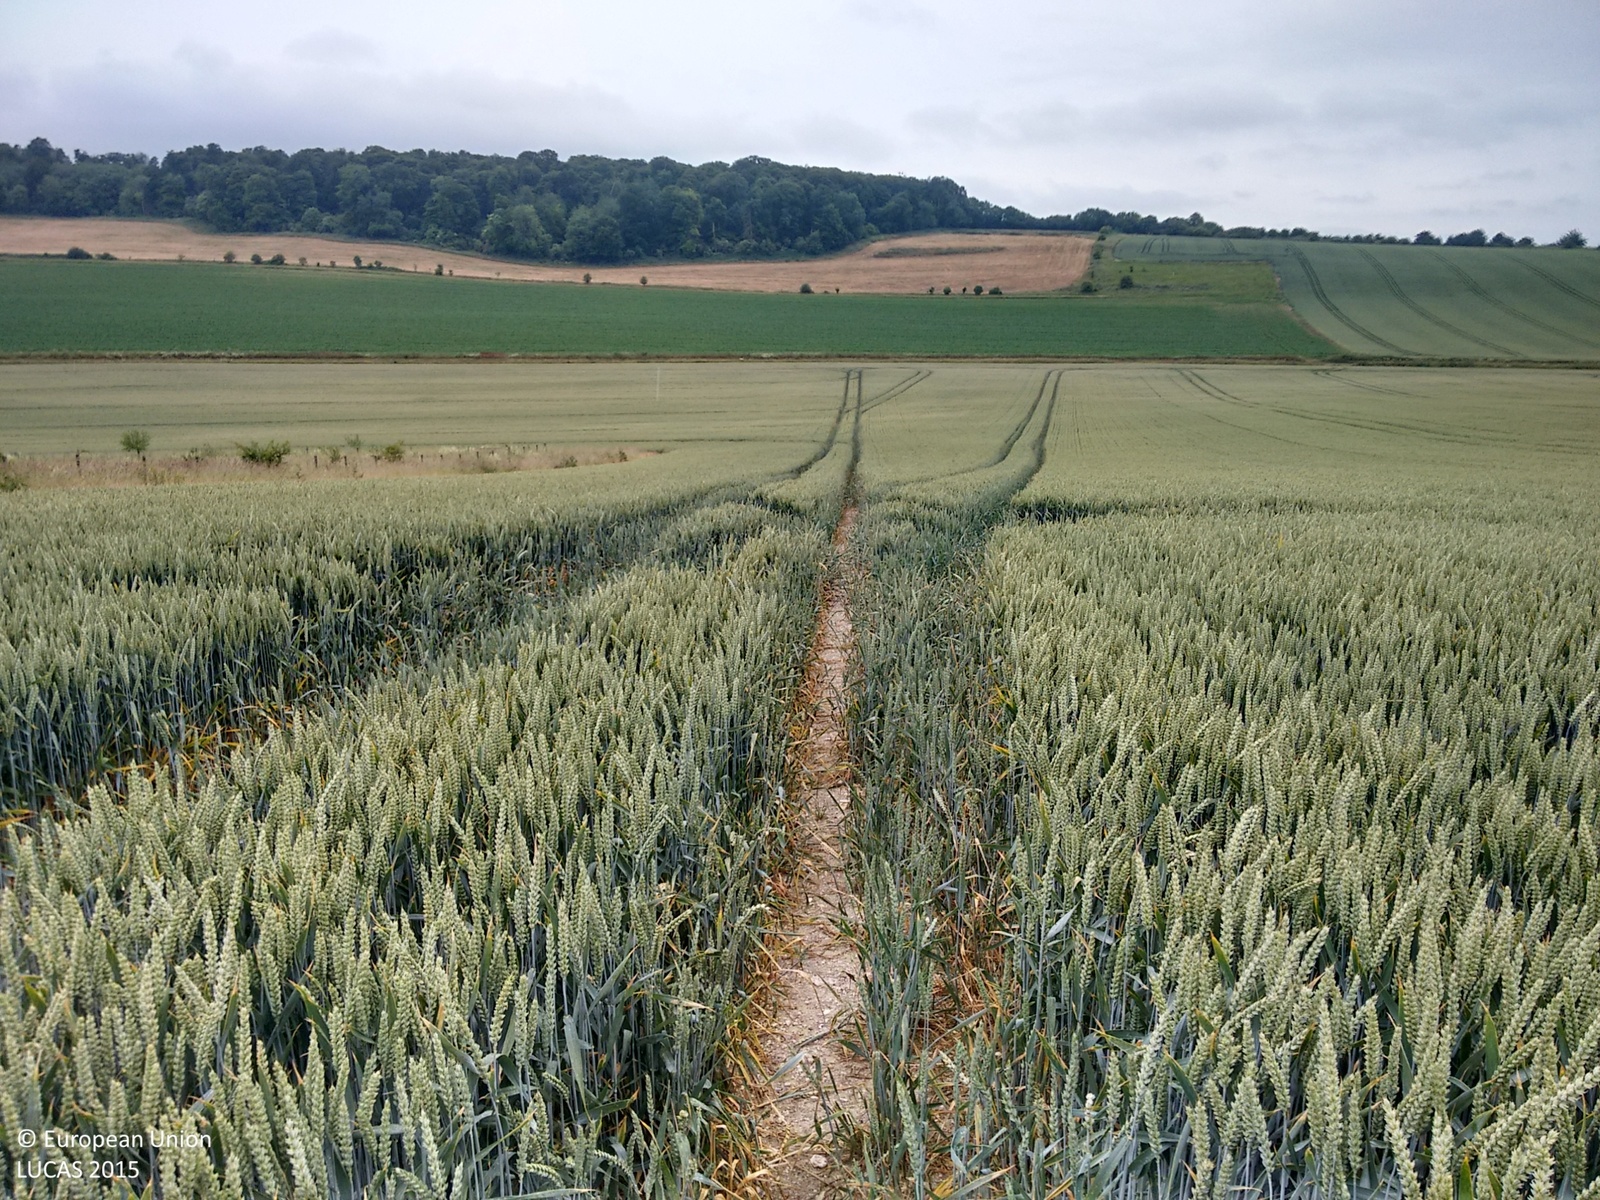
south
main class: Cropland
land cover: Common wheat
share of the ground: > 75 %
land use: Agriculture (excluding fallow land and kitchen gardens)
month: July
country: GB
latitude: 51.5487
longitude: -1.0775
